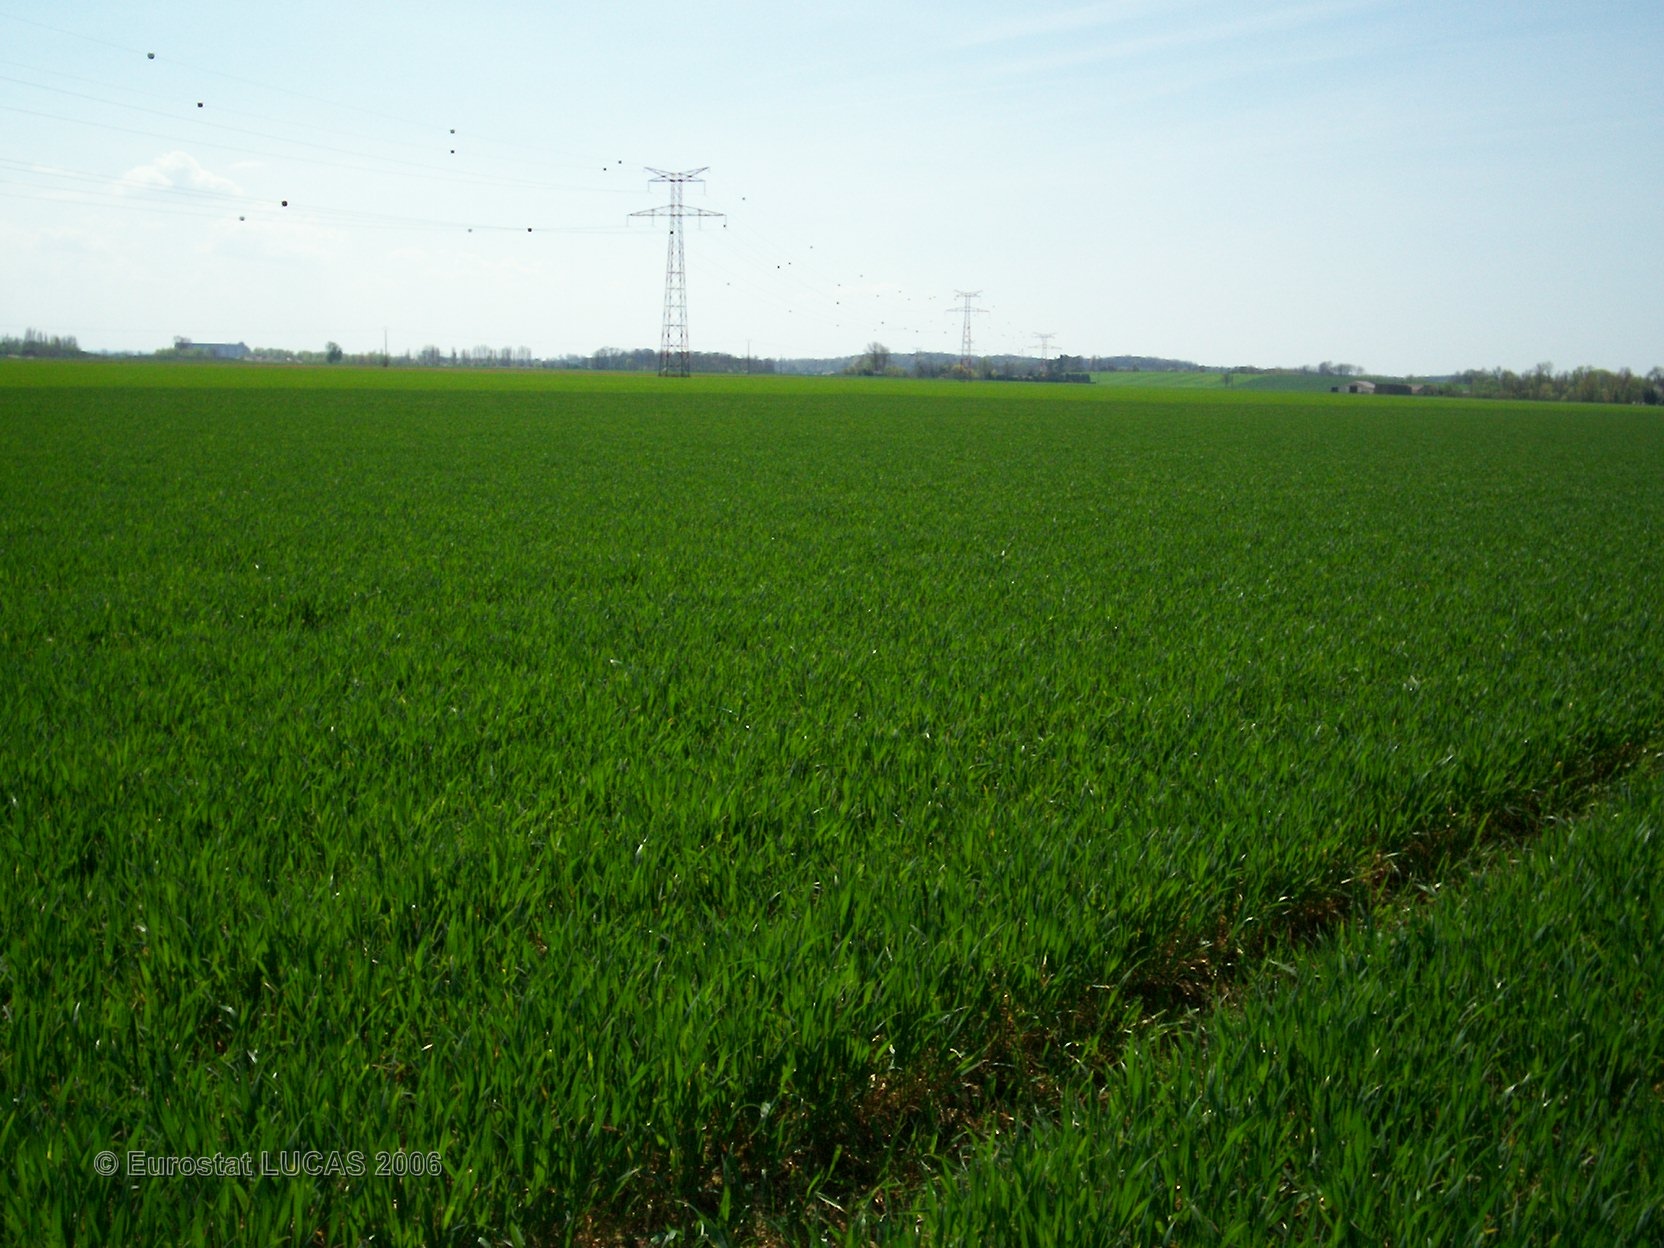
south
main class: Cropland
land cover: Common wheat
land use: Agriculture (excluding fallow land and kitchen gardens)
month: April
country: FR
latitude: 48.4301
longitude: 4.5238
